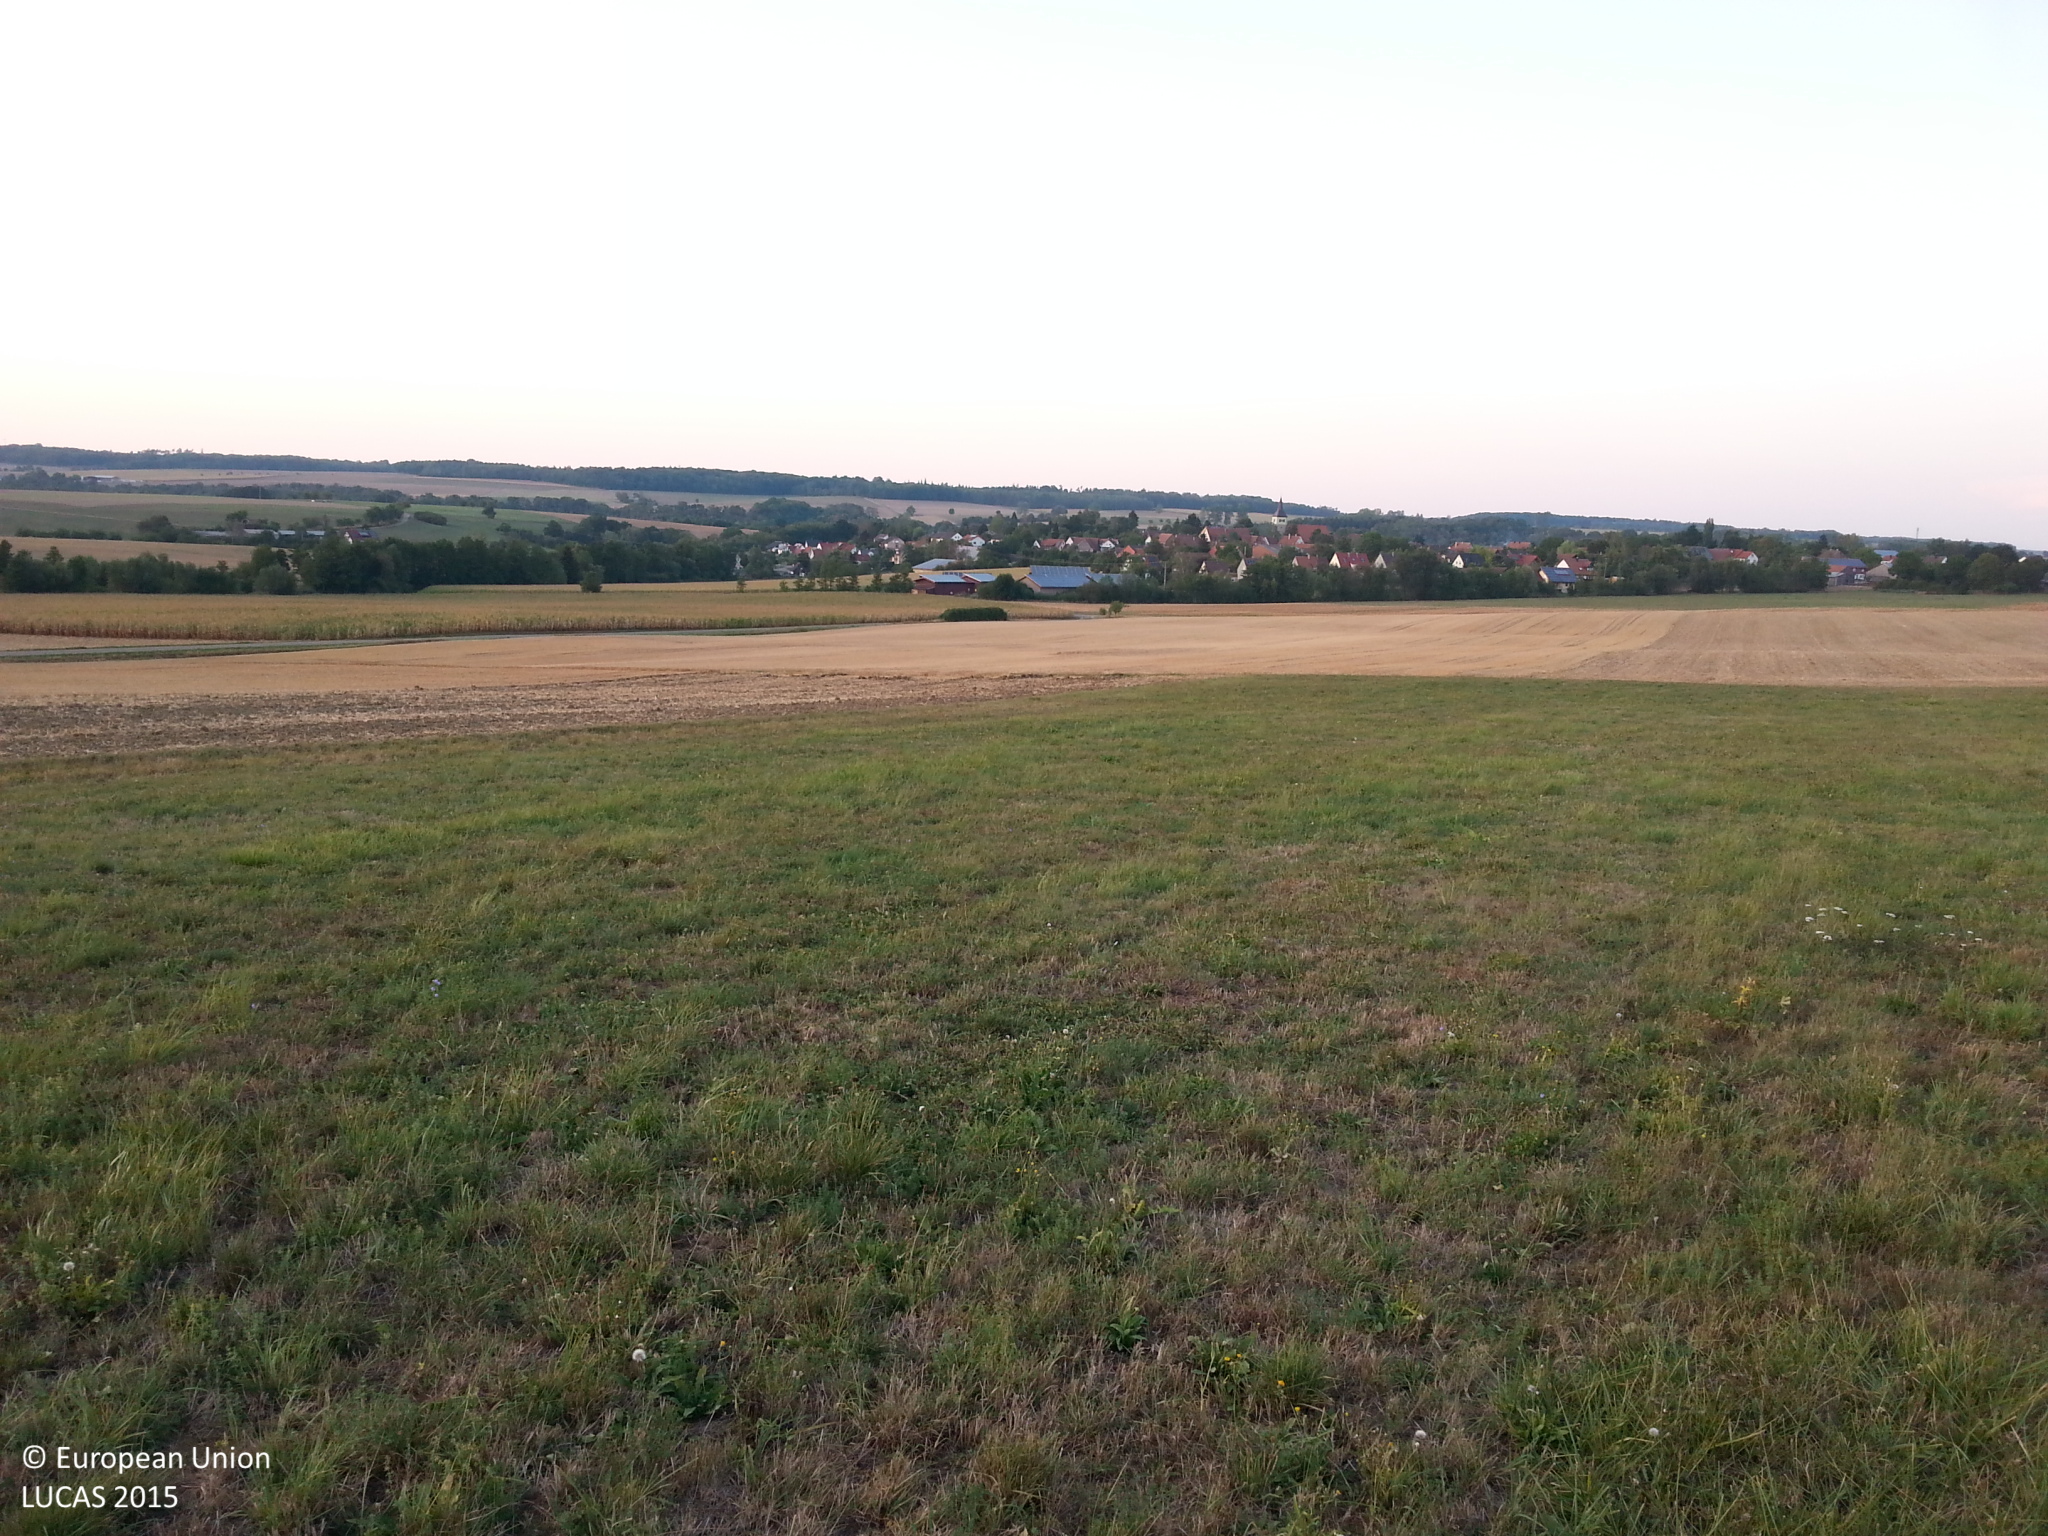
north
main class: Grassland
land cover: Grassland without tree/shrub cover
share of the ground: > 75 %
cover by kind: herbaceous plants 100 %
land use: Agriculture (excluding fallow land and kitchen gardens)
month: August
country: DE
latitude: 49.1951
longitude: 9.9588
